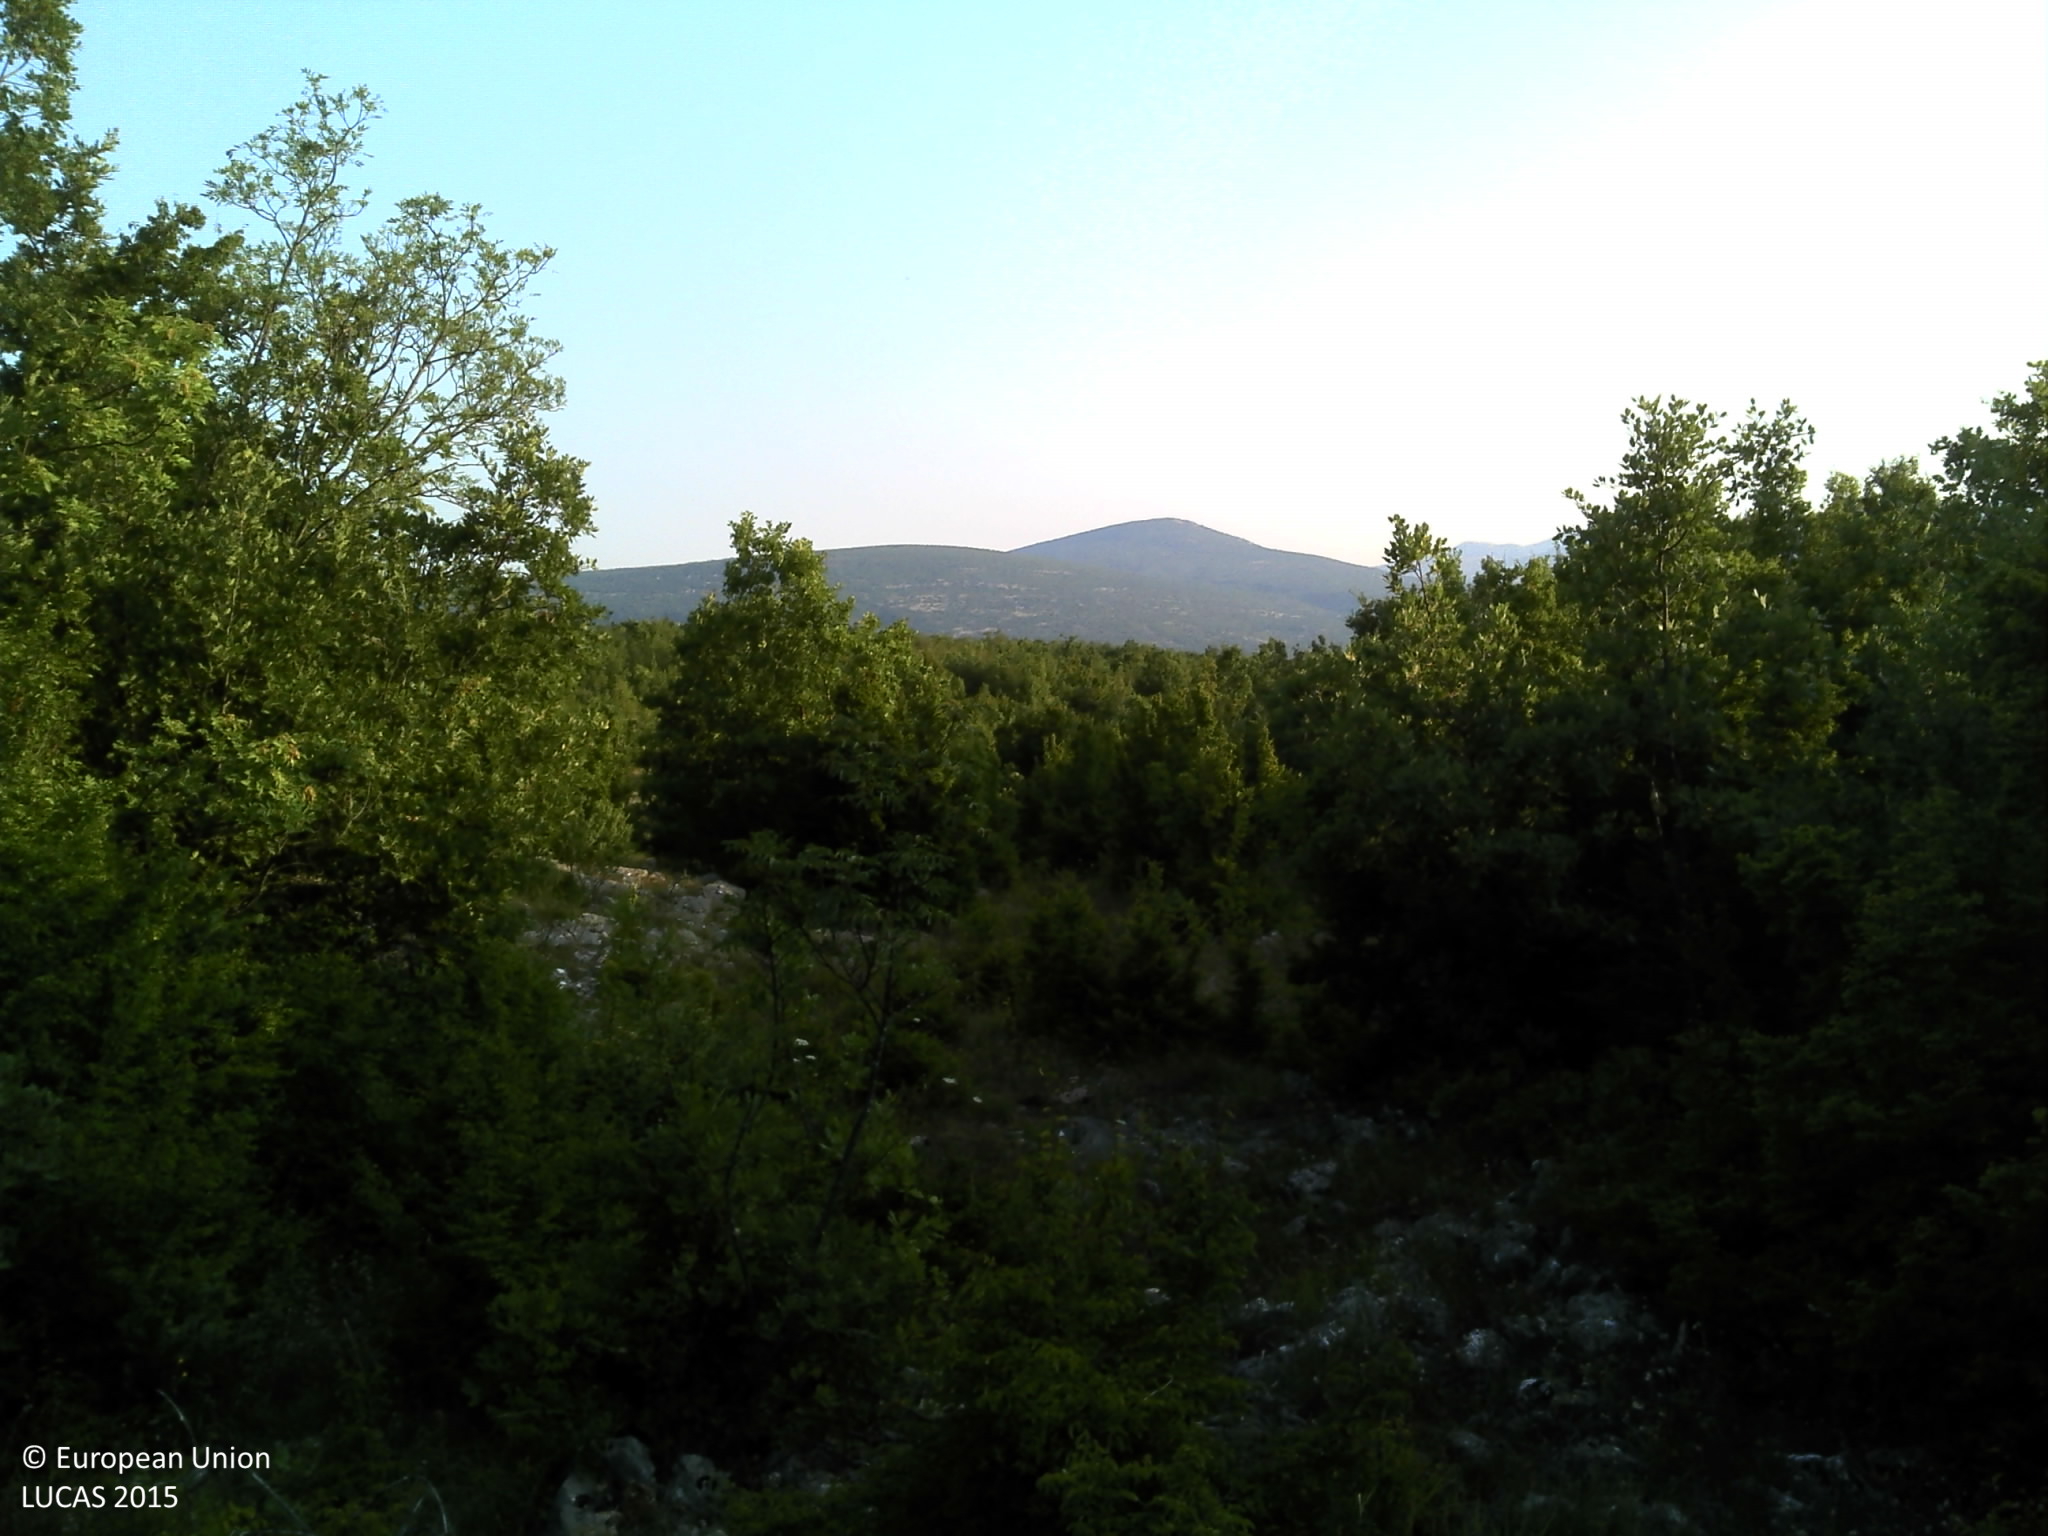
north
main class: Woodland
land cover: Broadleaved woodland
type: thermophilous deciduous forest
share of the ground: 50 - 75 %
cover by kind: broadleaved forest trees 50 %, shrubs 40 %, unconsolidated bare surface 10 %
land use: Semi-natural and natural areas not in use
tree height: > 5 m
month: July
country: HR
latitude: 44.0134
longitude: 16.3167
